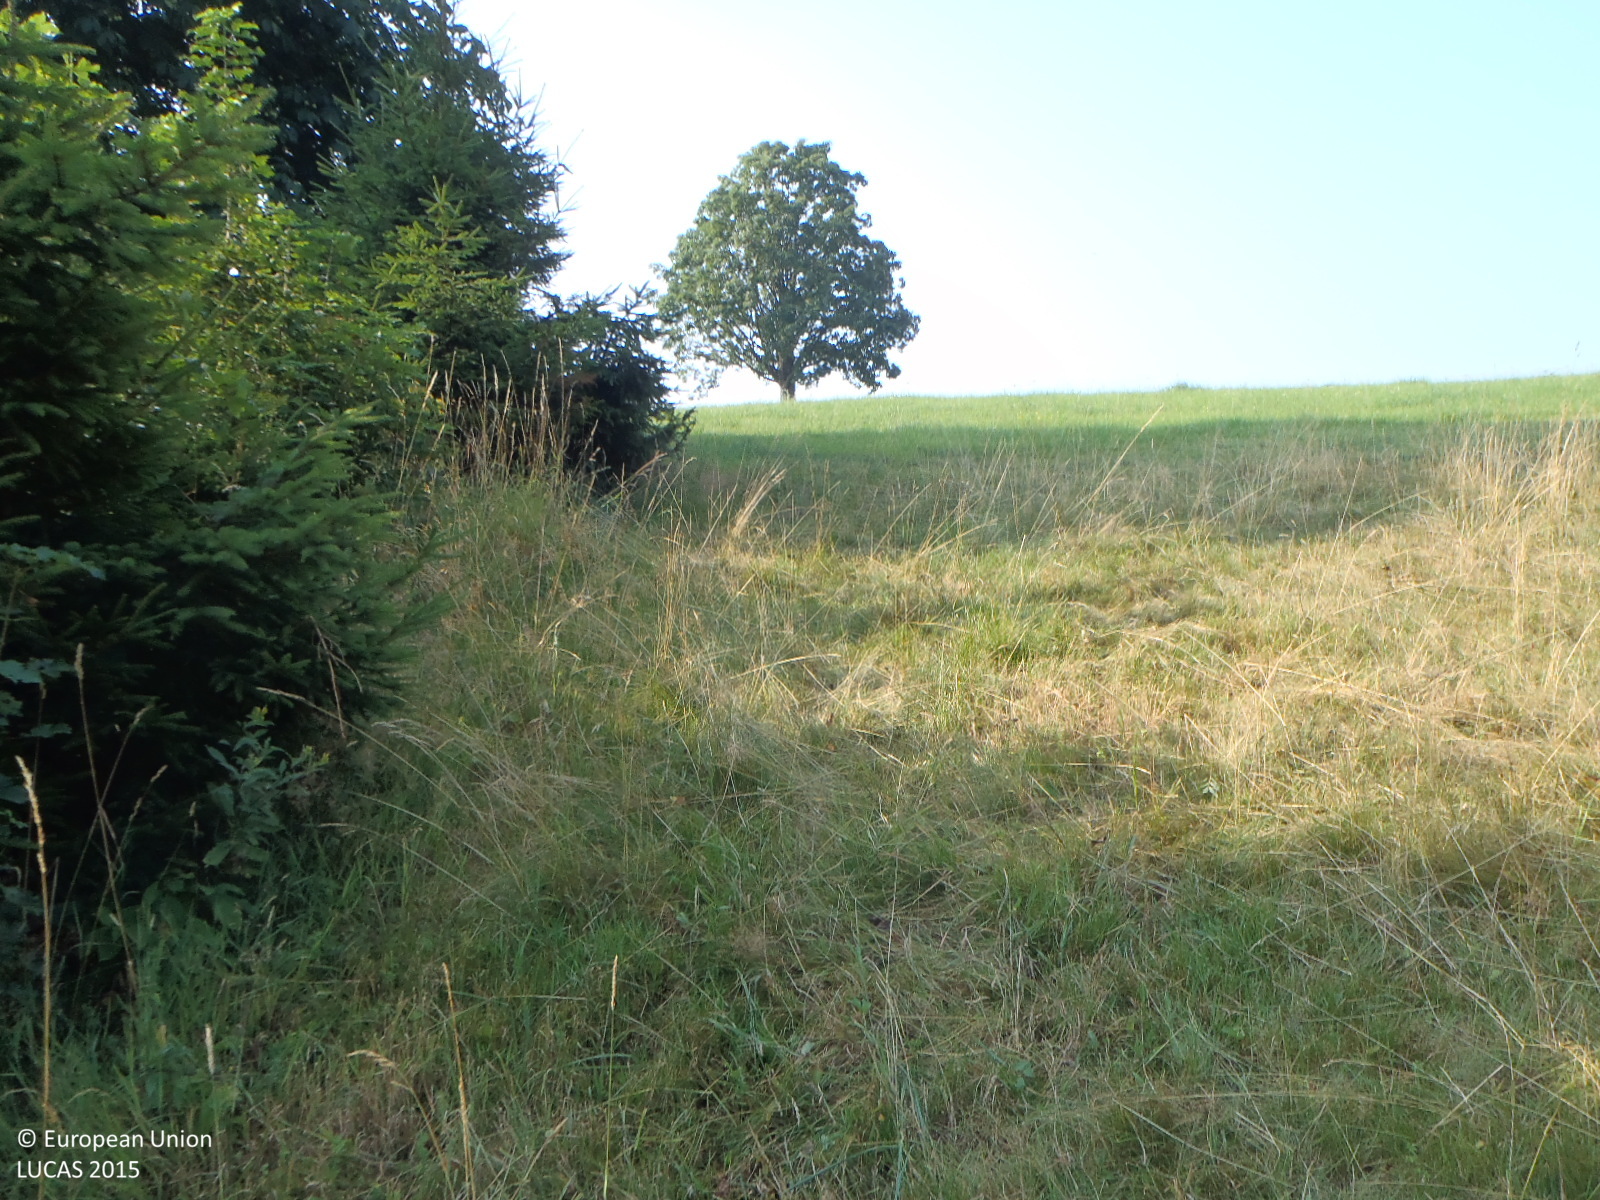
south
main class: Grassland
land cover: Grassland without tree/shrub cover
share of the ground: > 75 %
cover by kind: herbaceous plants 100 %
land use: Agriculture (excluding fallow land and kitchen gardens)
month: August
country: CZ
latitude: 50.7488
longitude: 15.2334
